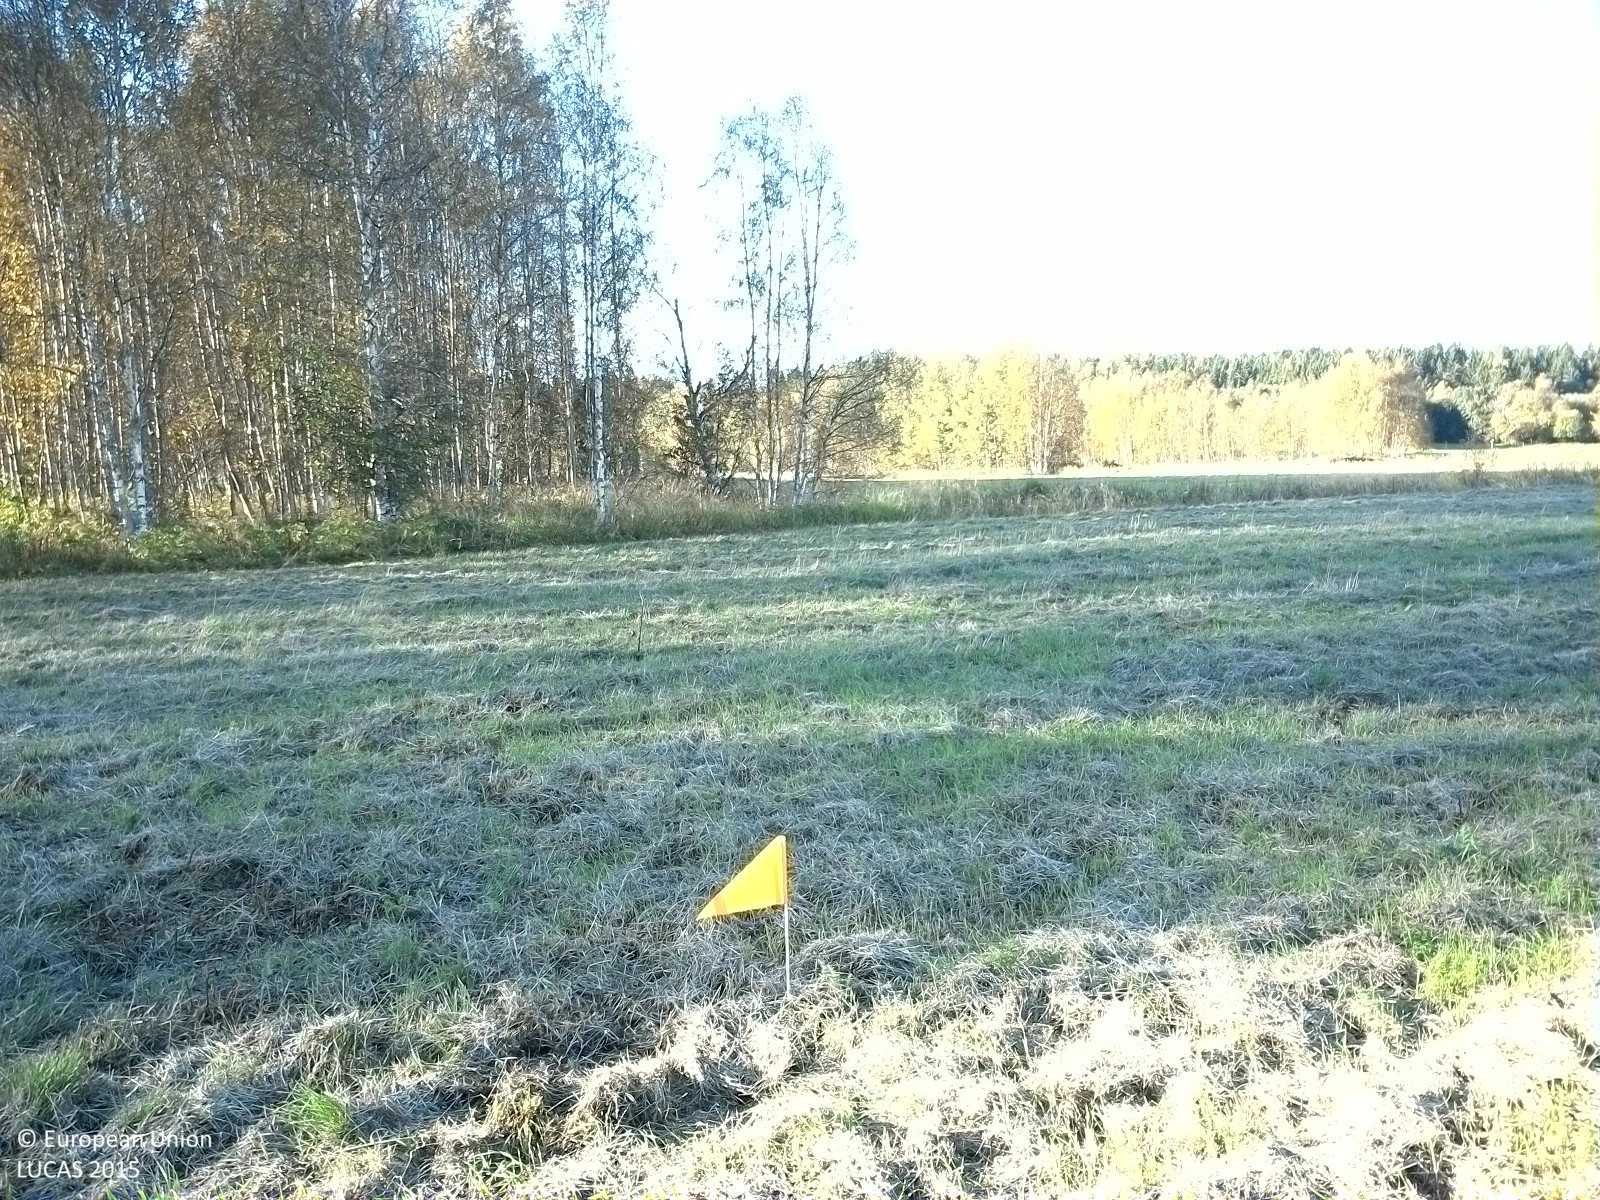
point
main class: Cropland
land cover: Temporary grasslands
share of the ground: > 75 %
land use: Agriculture (excluding fallow land and kitchen gardens)
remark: Harvested field
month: September
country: SE
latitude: 61.9346
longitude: 17.1658
